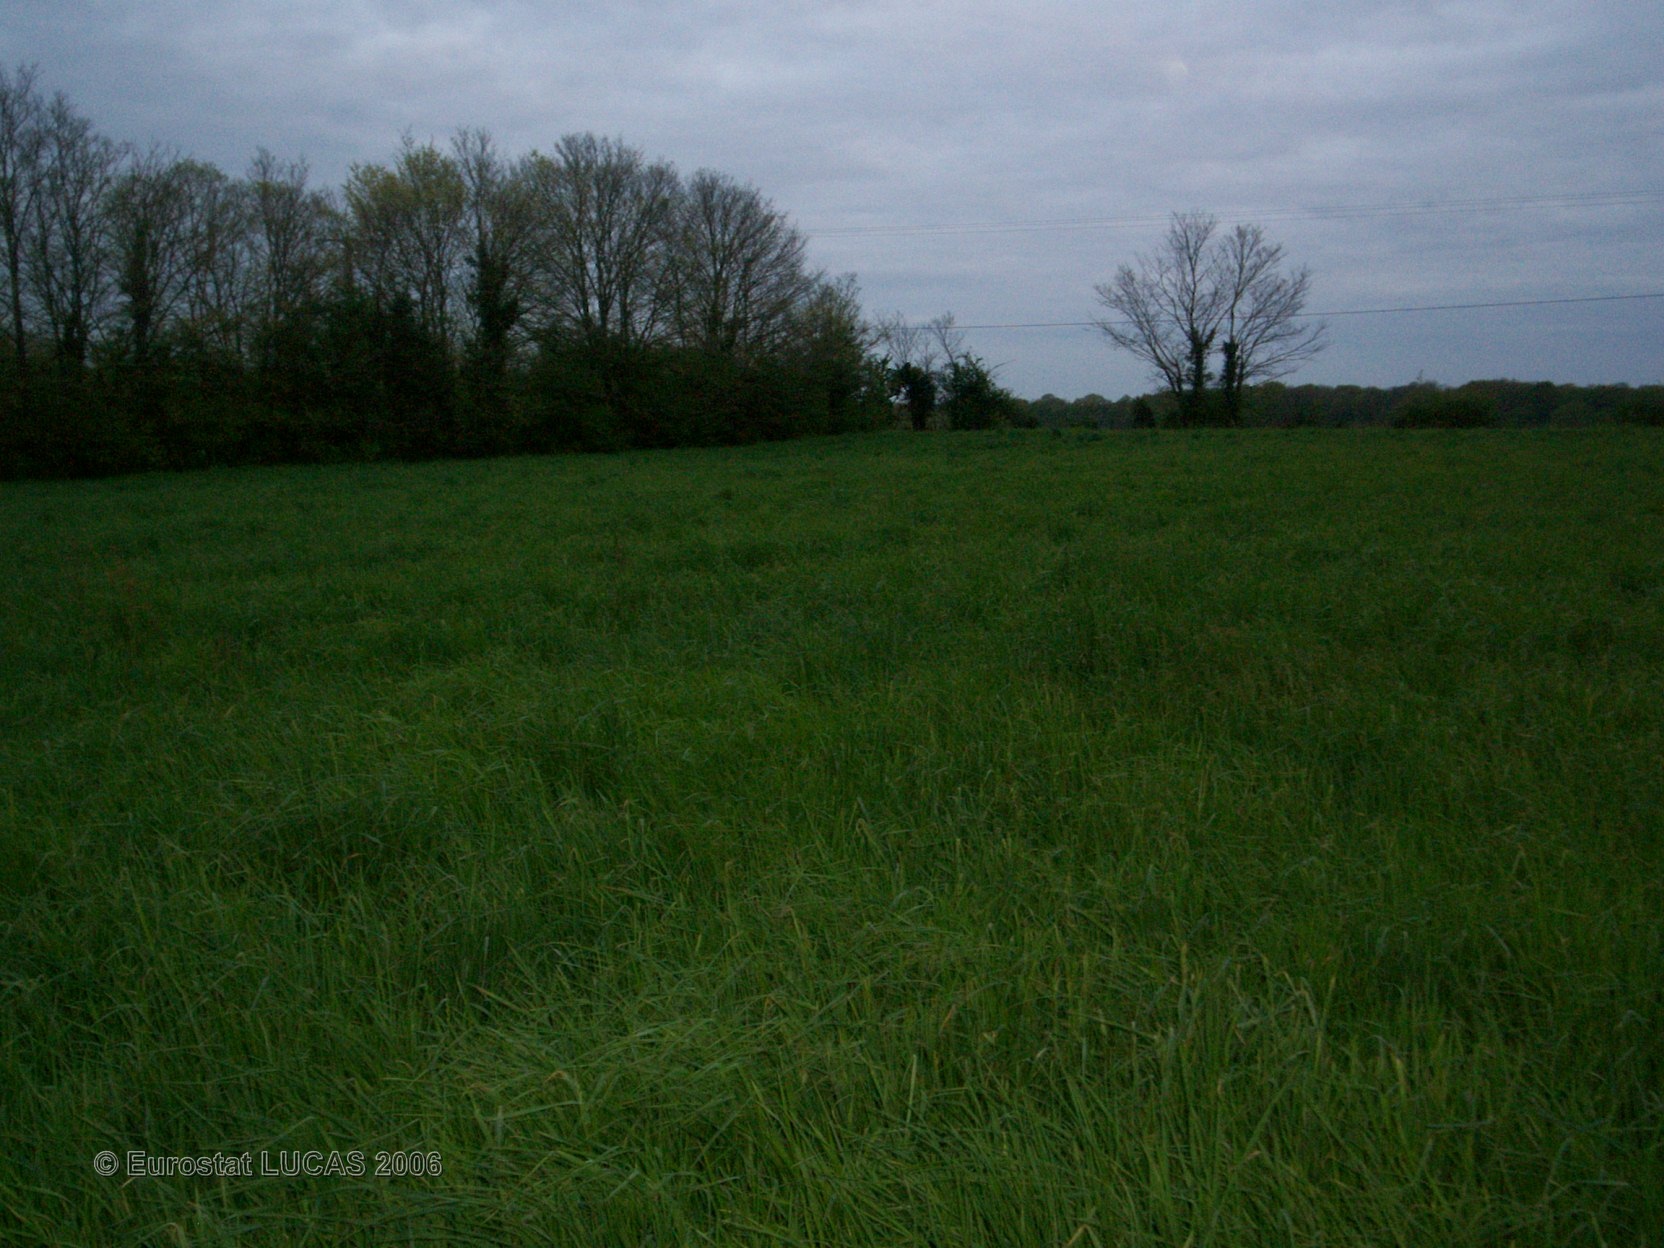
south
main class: Grassland
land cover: Grassland without tree/shrub cover
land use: Agriculture (excluding fallow land and kitchen gardens)
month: May
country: FR
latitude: 47.8604
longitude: -0.1745
